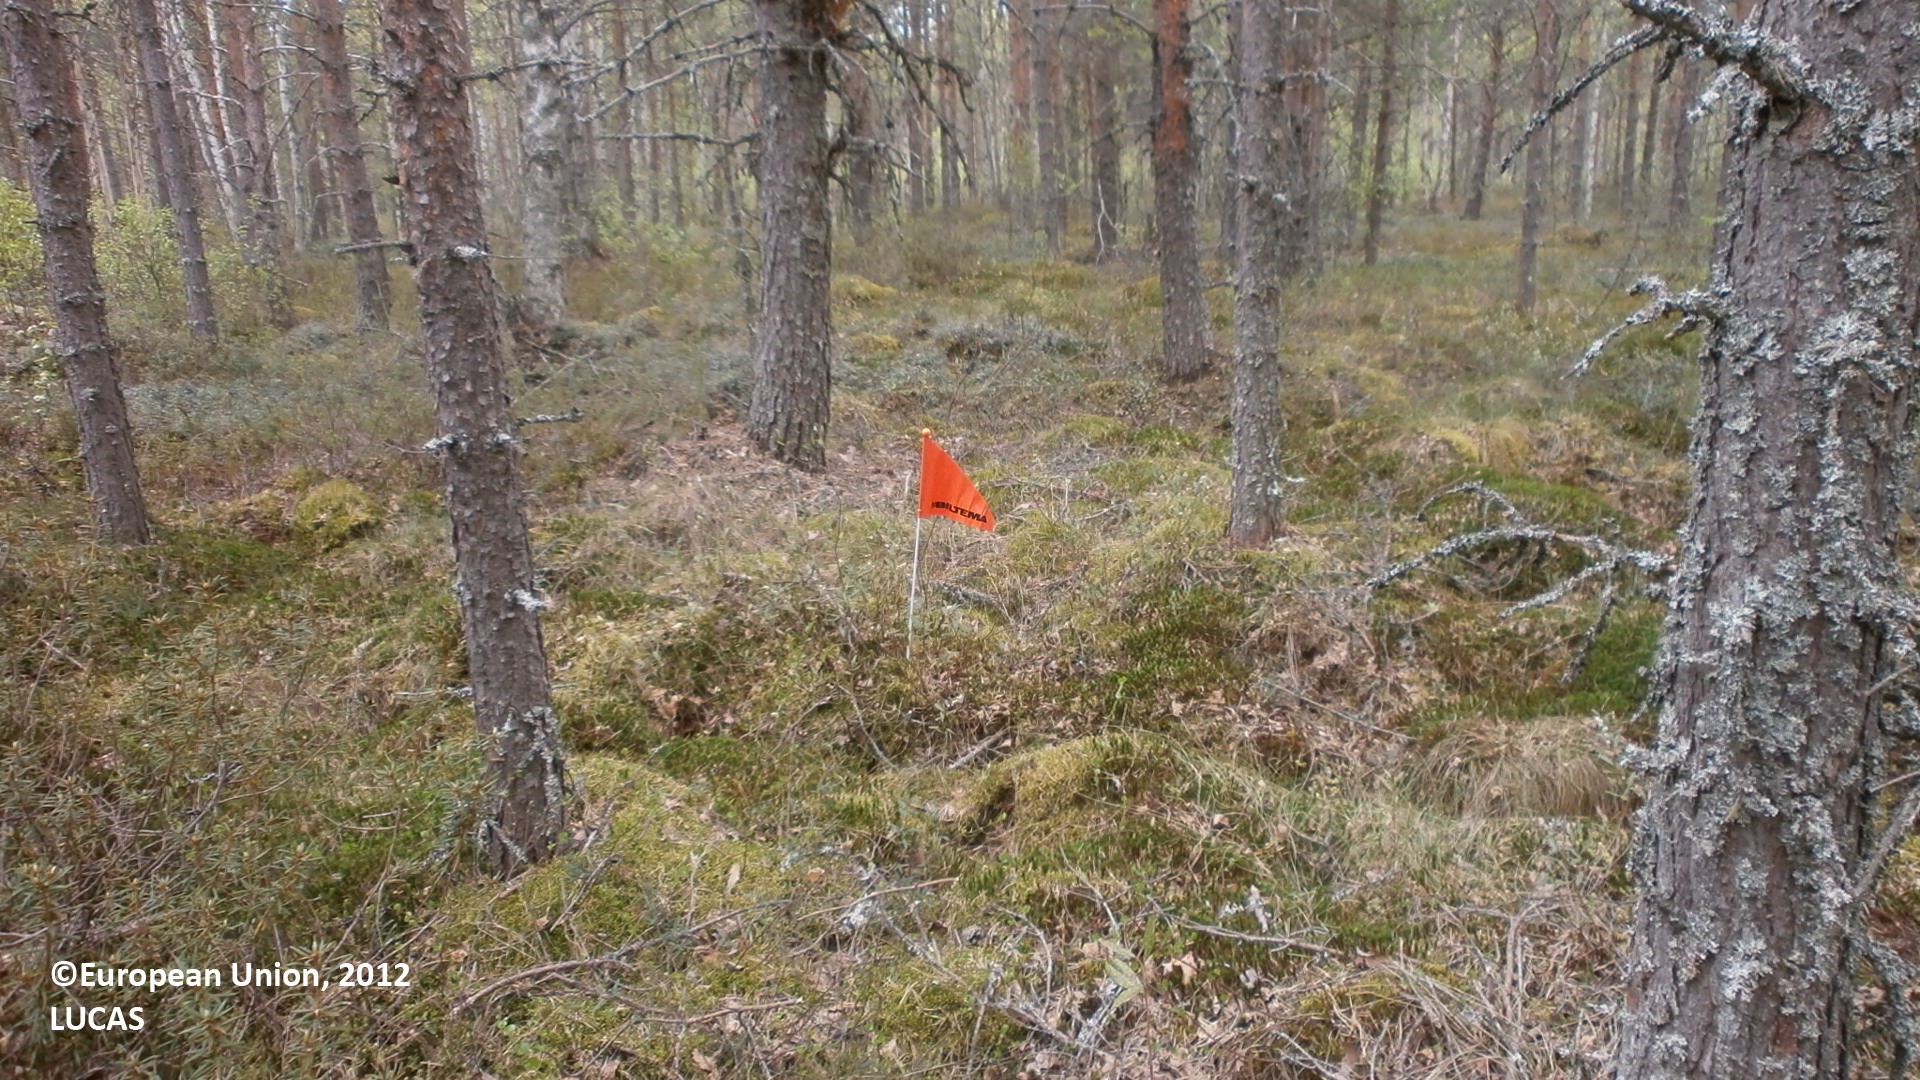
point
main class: Woodland
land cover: Pine dominated coniferous woodland
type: mire and swamp forests
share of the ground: > 75 %
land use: Forestry
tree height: > 5 m
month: May
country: FI
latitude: 64.4744
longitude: 25.9284
